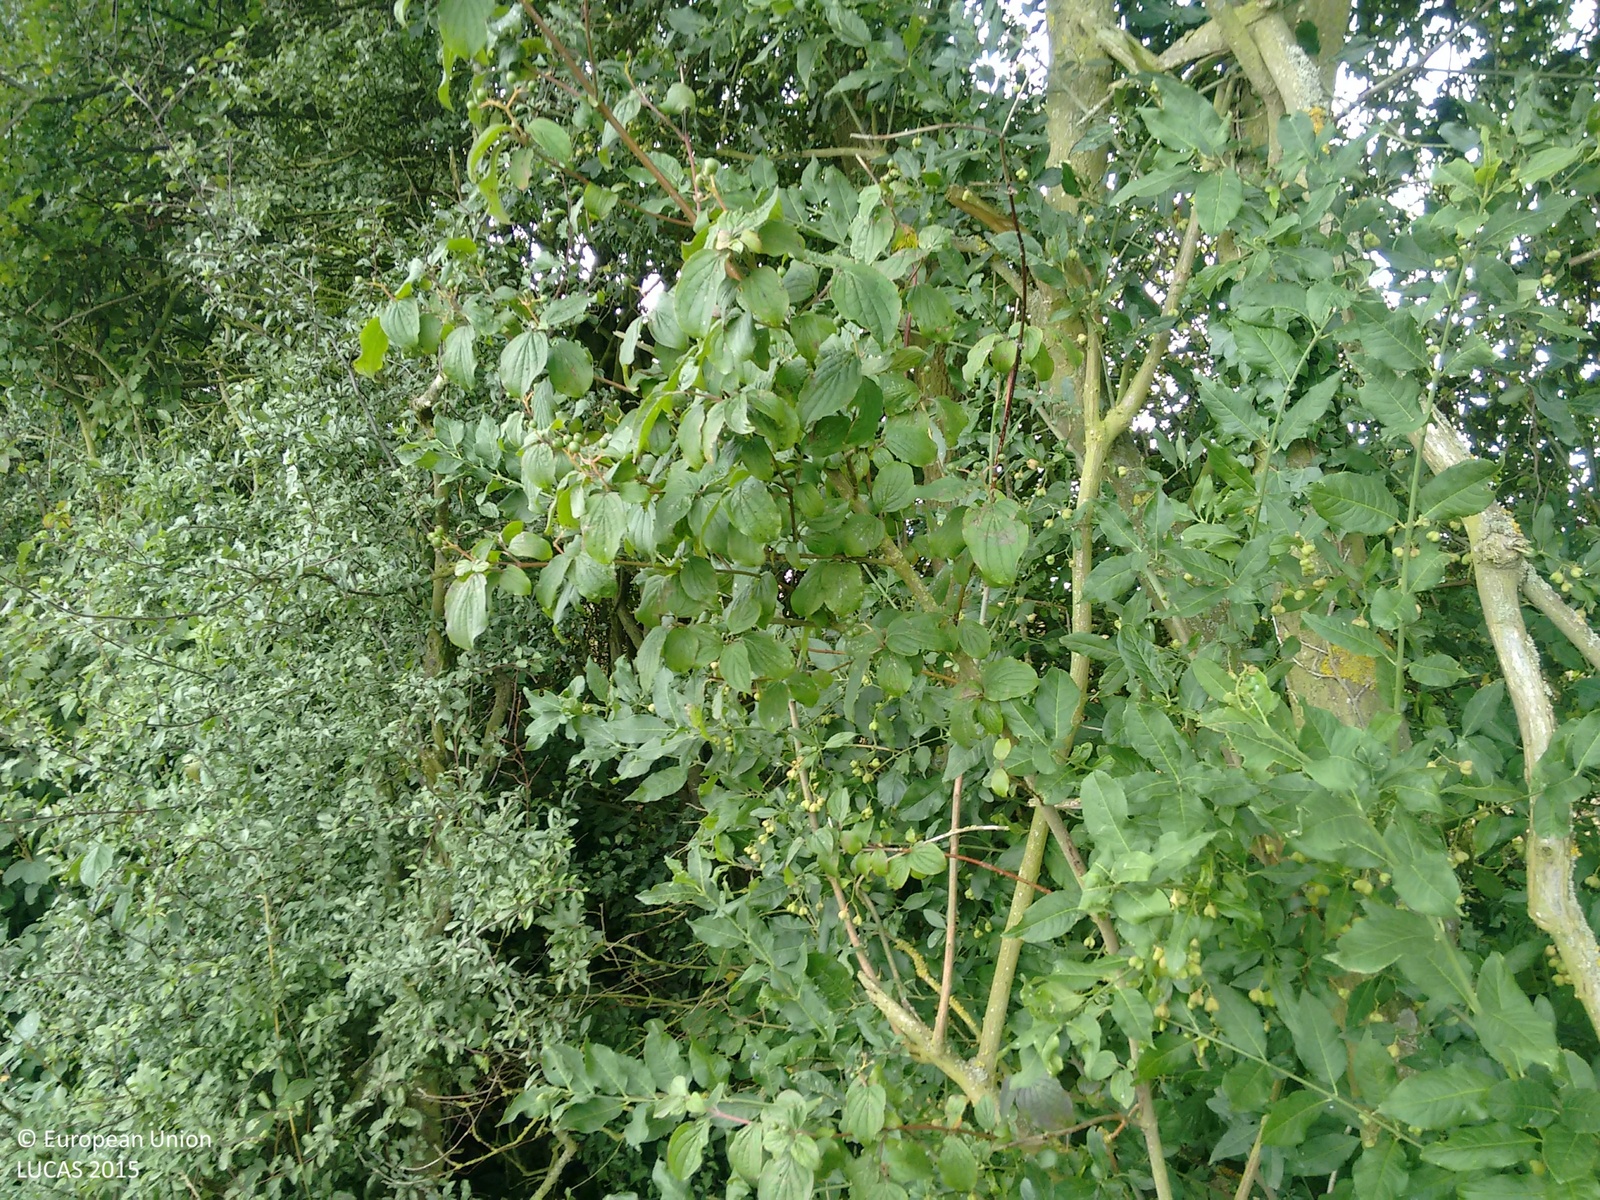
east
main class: Grassland
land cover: Grassland without tree/shrub cover
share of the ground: > 75 %
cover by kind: herbaceous plants 100 %
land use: Agriculture (excluding fallow land and kitchen gardens)
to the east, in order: Grassland without tree/shrub cover; Fences; Ditches and canals; Managed hedges; Grass margins; Rape and turnip rape; Electric lines; Rape and turnip rape; Grassland without tree/shrub cover; Ditches and canals; Grassland without tree/shrub cover
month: August
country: GB
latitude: 52.0850
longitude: 0.9429
